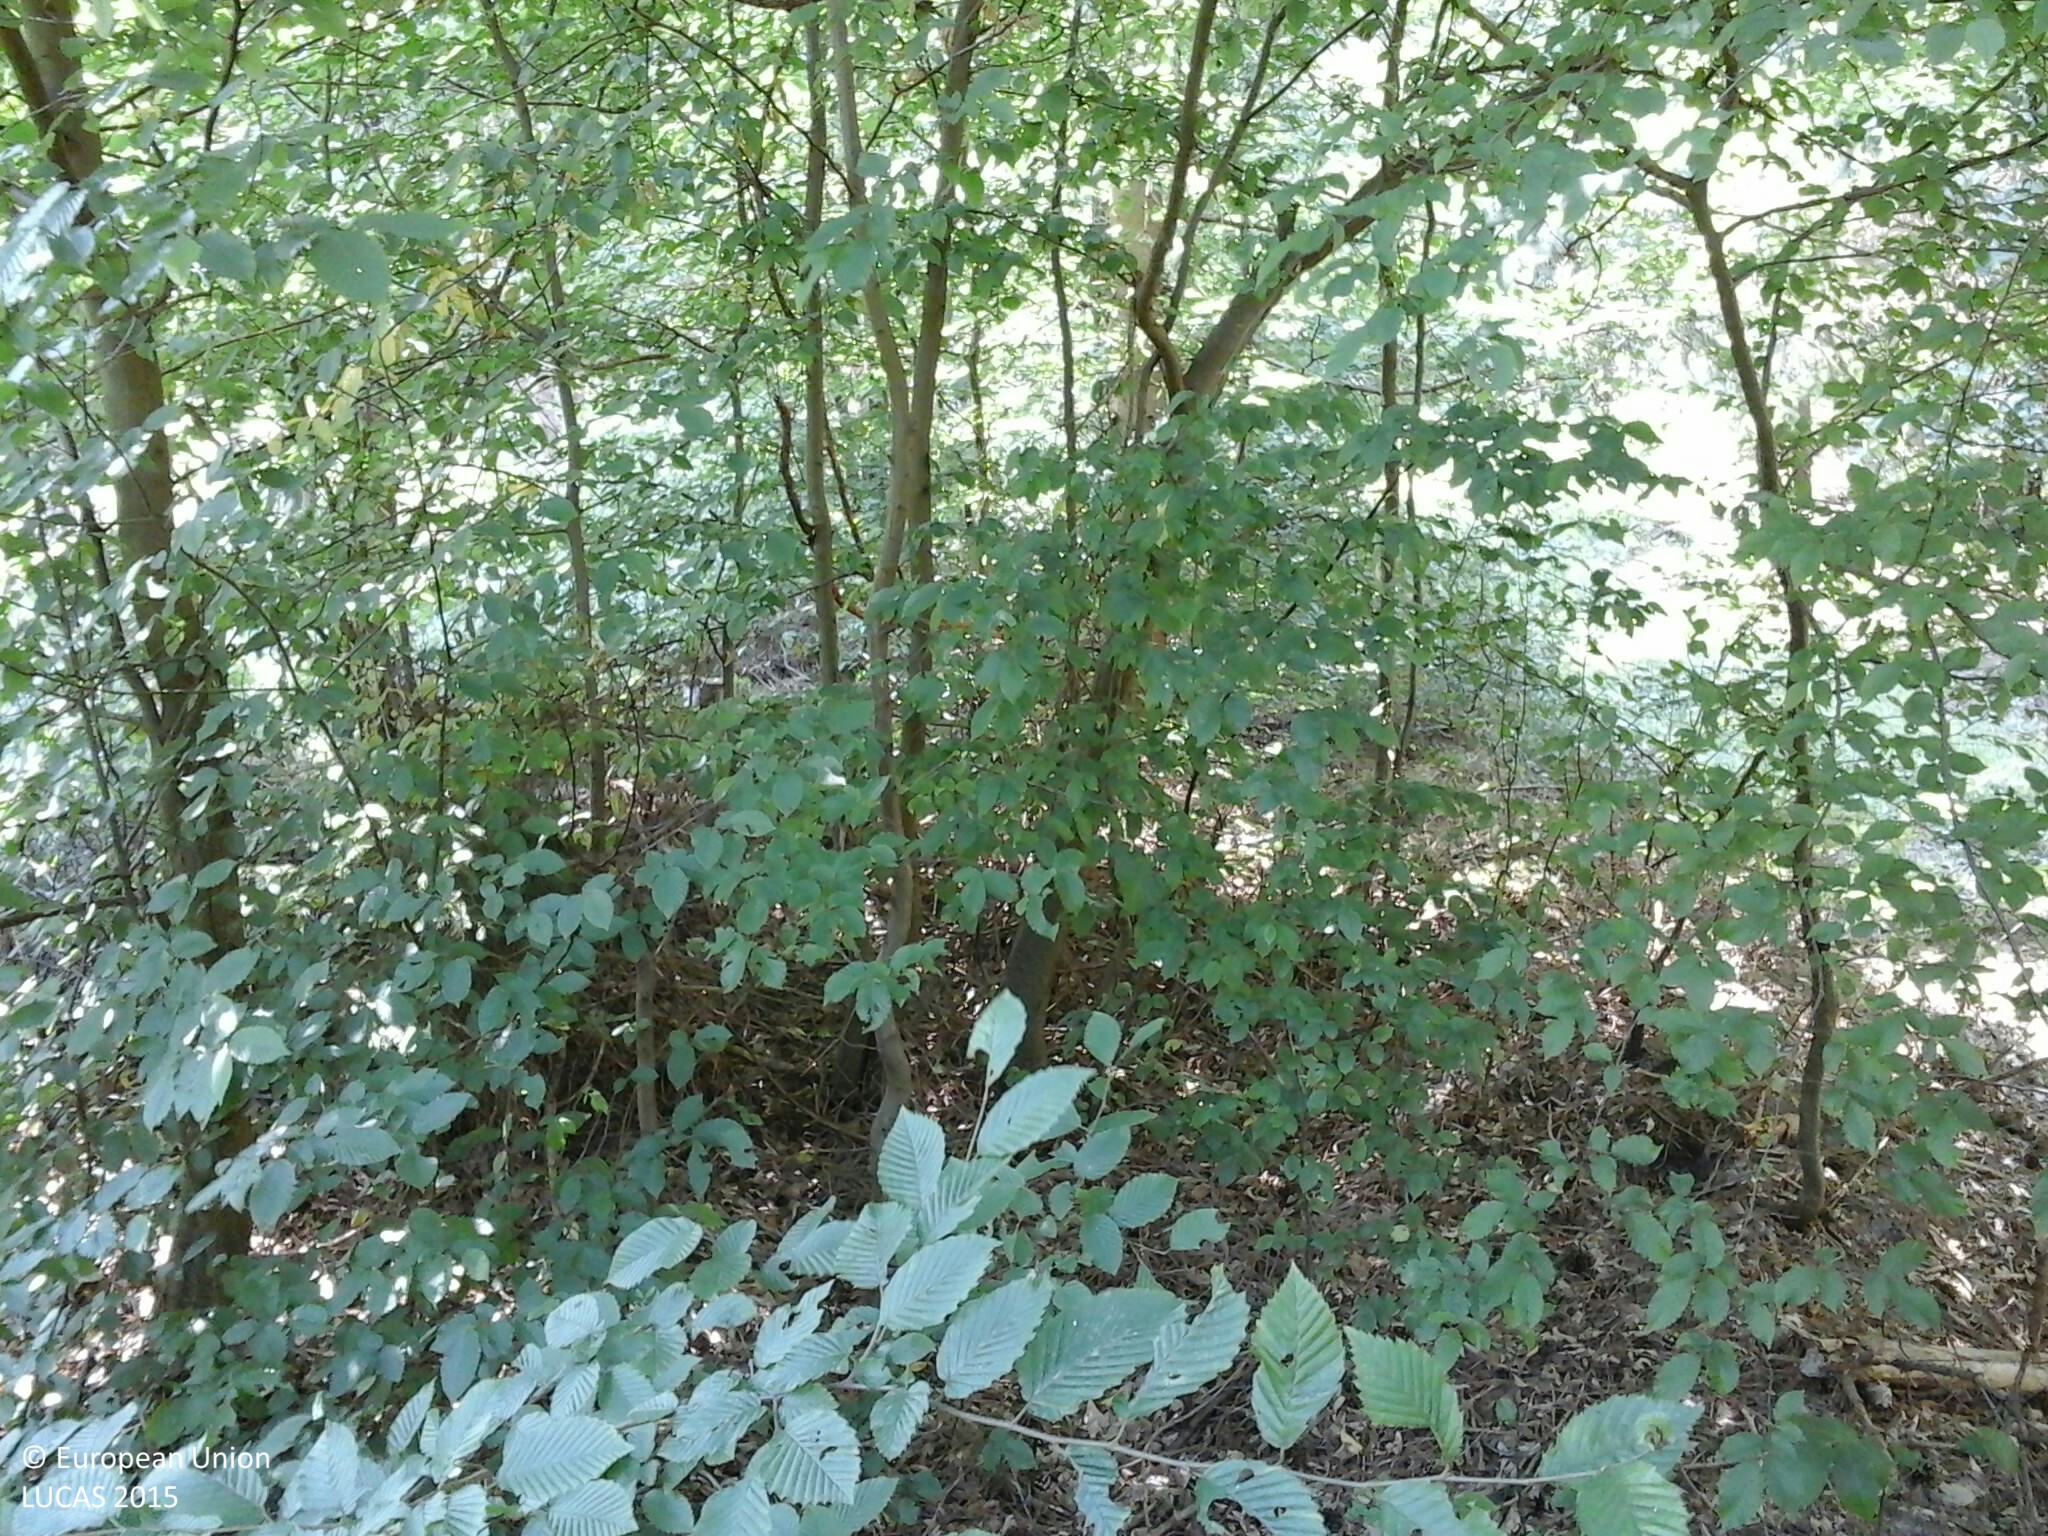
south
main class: Woodland
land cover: Pine dominated coniferous woodland
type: hemiboreal forest and nemoral coniferous forest and mixed broadleaved-coniferous forest
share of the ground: > 75 %
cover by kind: coniferous forest trees 70 %, broadleaved forest trees 20 %, shrubs 10 %
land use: Forestry
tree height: > 5 m
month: July
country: HU
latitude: 46.9424
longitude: 16.2944
